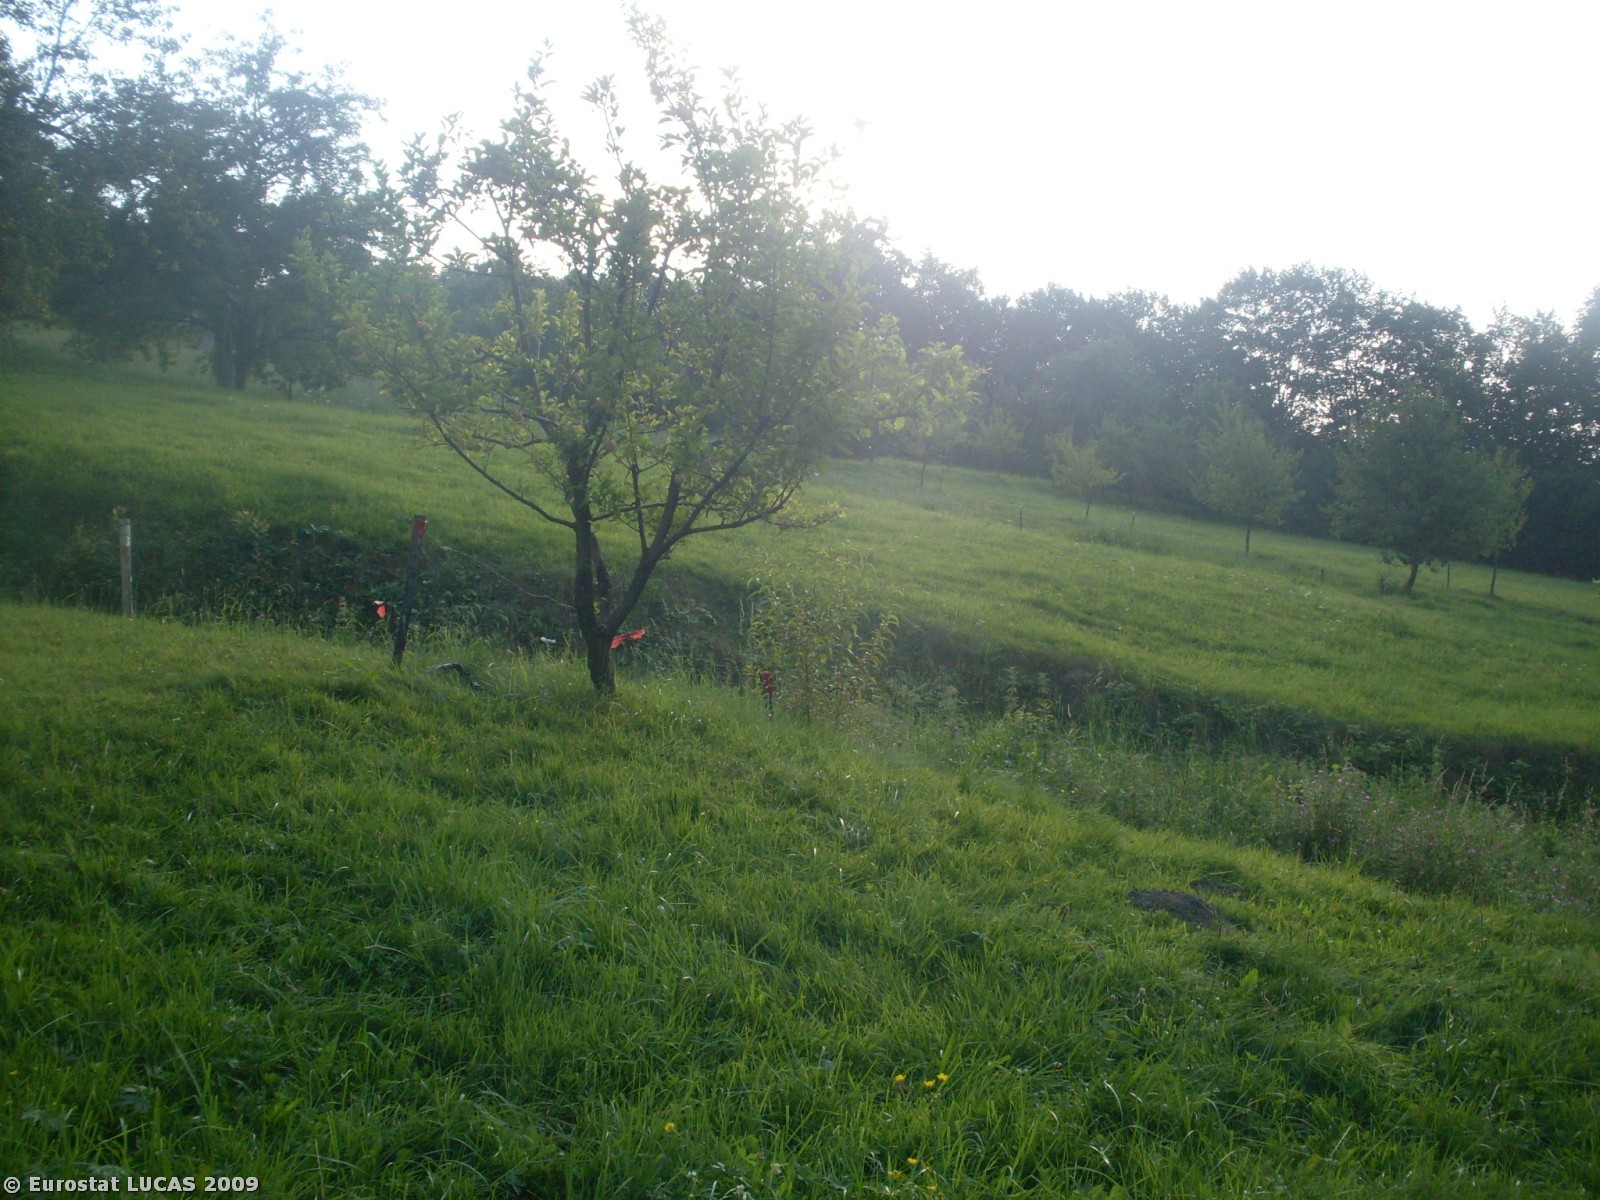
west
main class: Cropland
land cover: Apple fruit
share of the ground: 50 - 75 %
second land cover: Grassland with sparse tree/shrub cover
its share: > 75 %
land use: Agriculture (excluding fallow land and kitchen gardens)
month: July
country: PL
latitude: 49.7890
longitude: 20.4966
